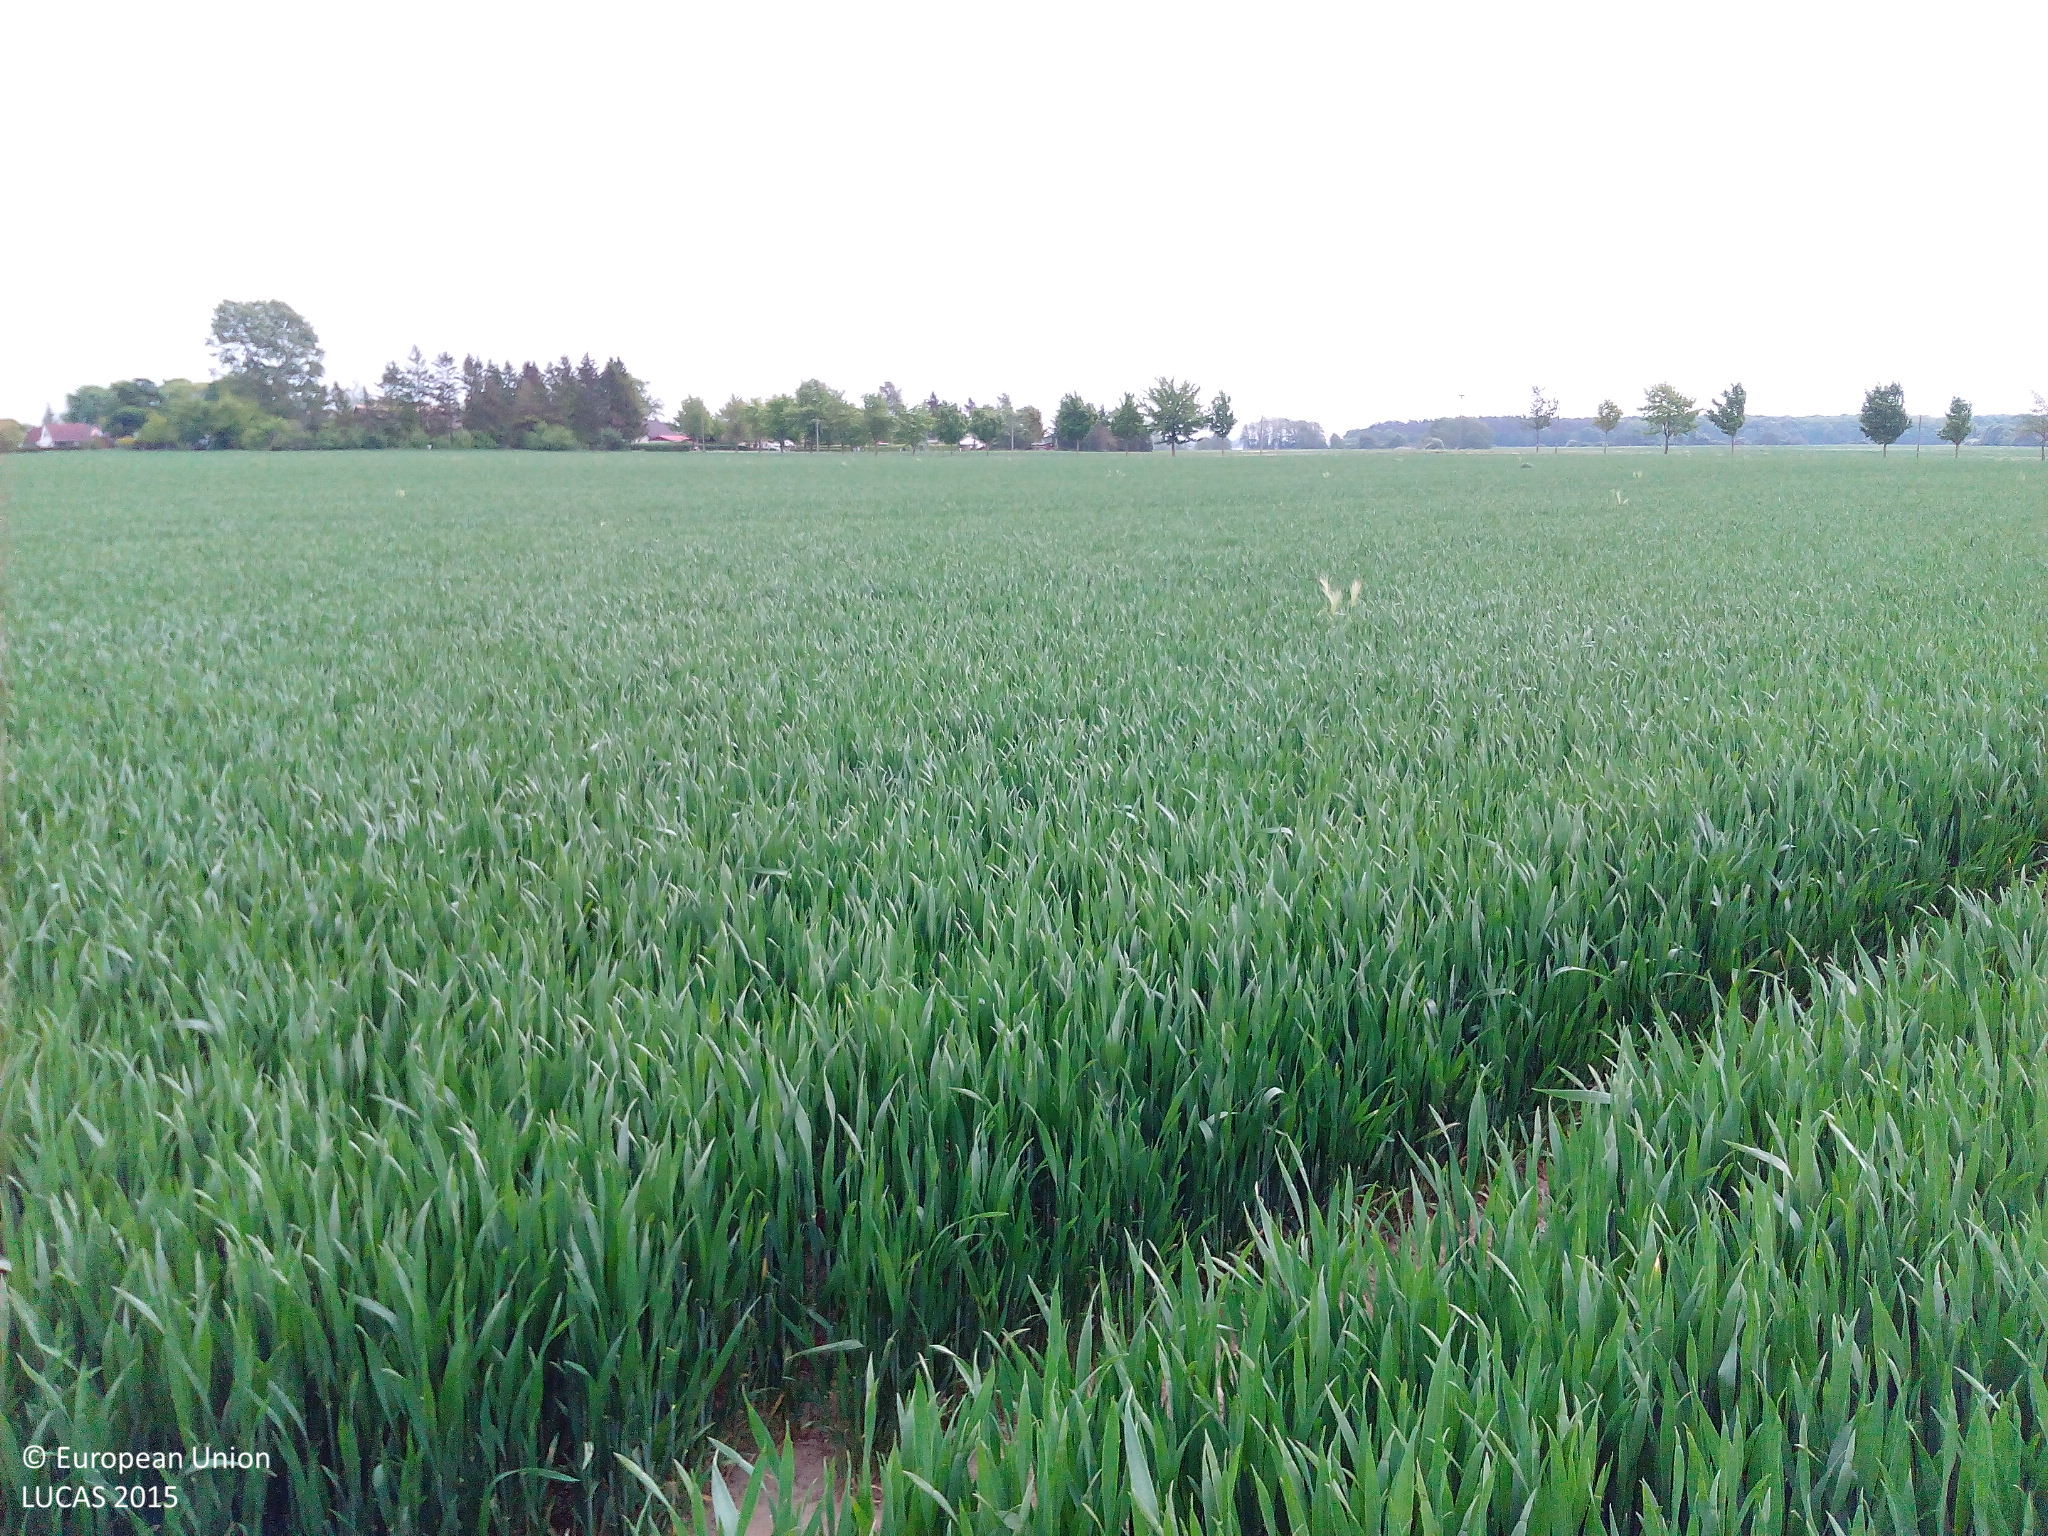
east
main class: Cropland
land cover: Barley
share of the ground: > 75 %
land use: Agriculture (excluding fallow land and kitchen gardens)
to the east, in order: Barley
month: May
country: DE
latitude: 54.2026
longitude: 13.2952
